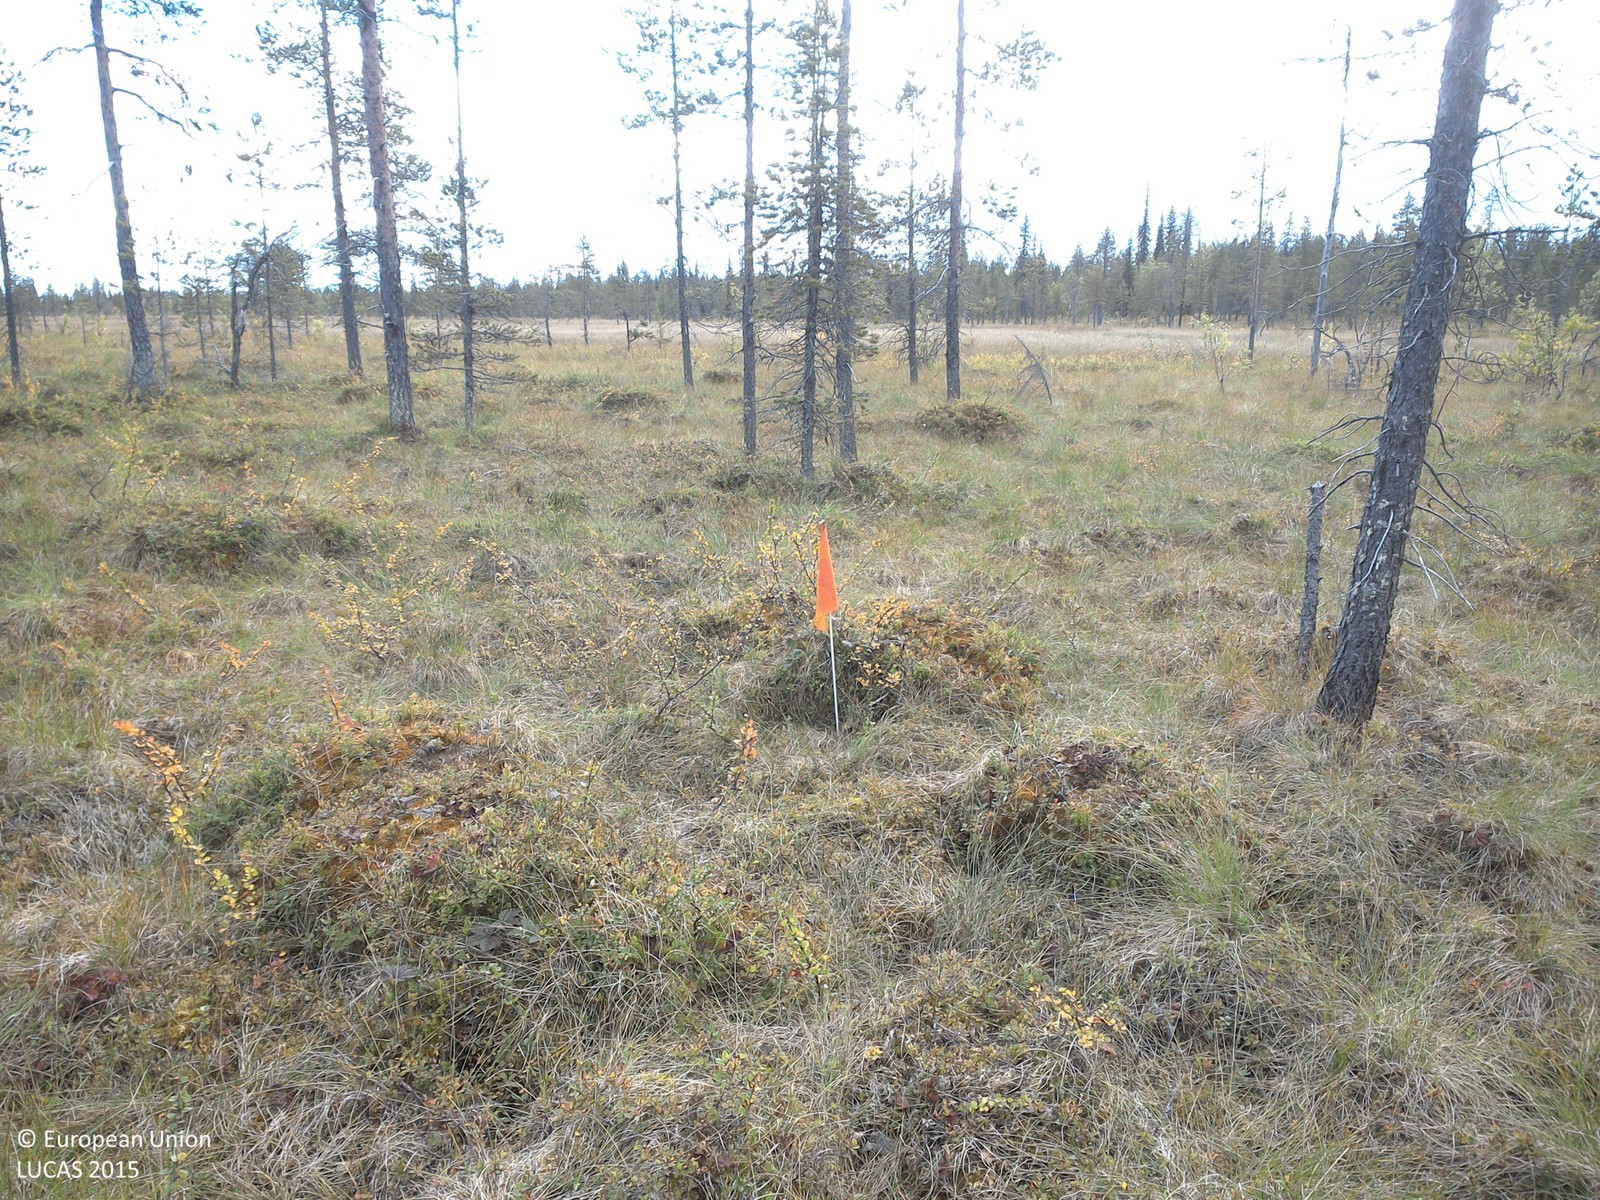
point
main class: Woodland
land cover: Pine dominated coniferous woodland
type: boreal forest
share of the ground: 10 - 25 %
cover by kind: shrubs 60 %, coniferous forest trees 15 %, lichens and mosses 15 %, herbaceous plants 10 %
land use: Forestry
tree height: > 5 m
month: September
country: SE
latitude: 67.8627
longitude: 23.1091
